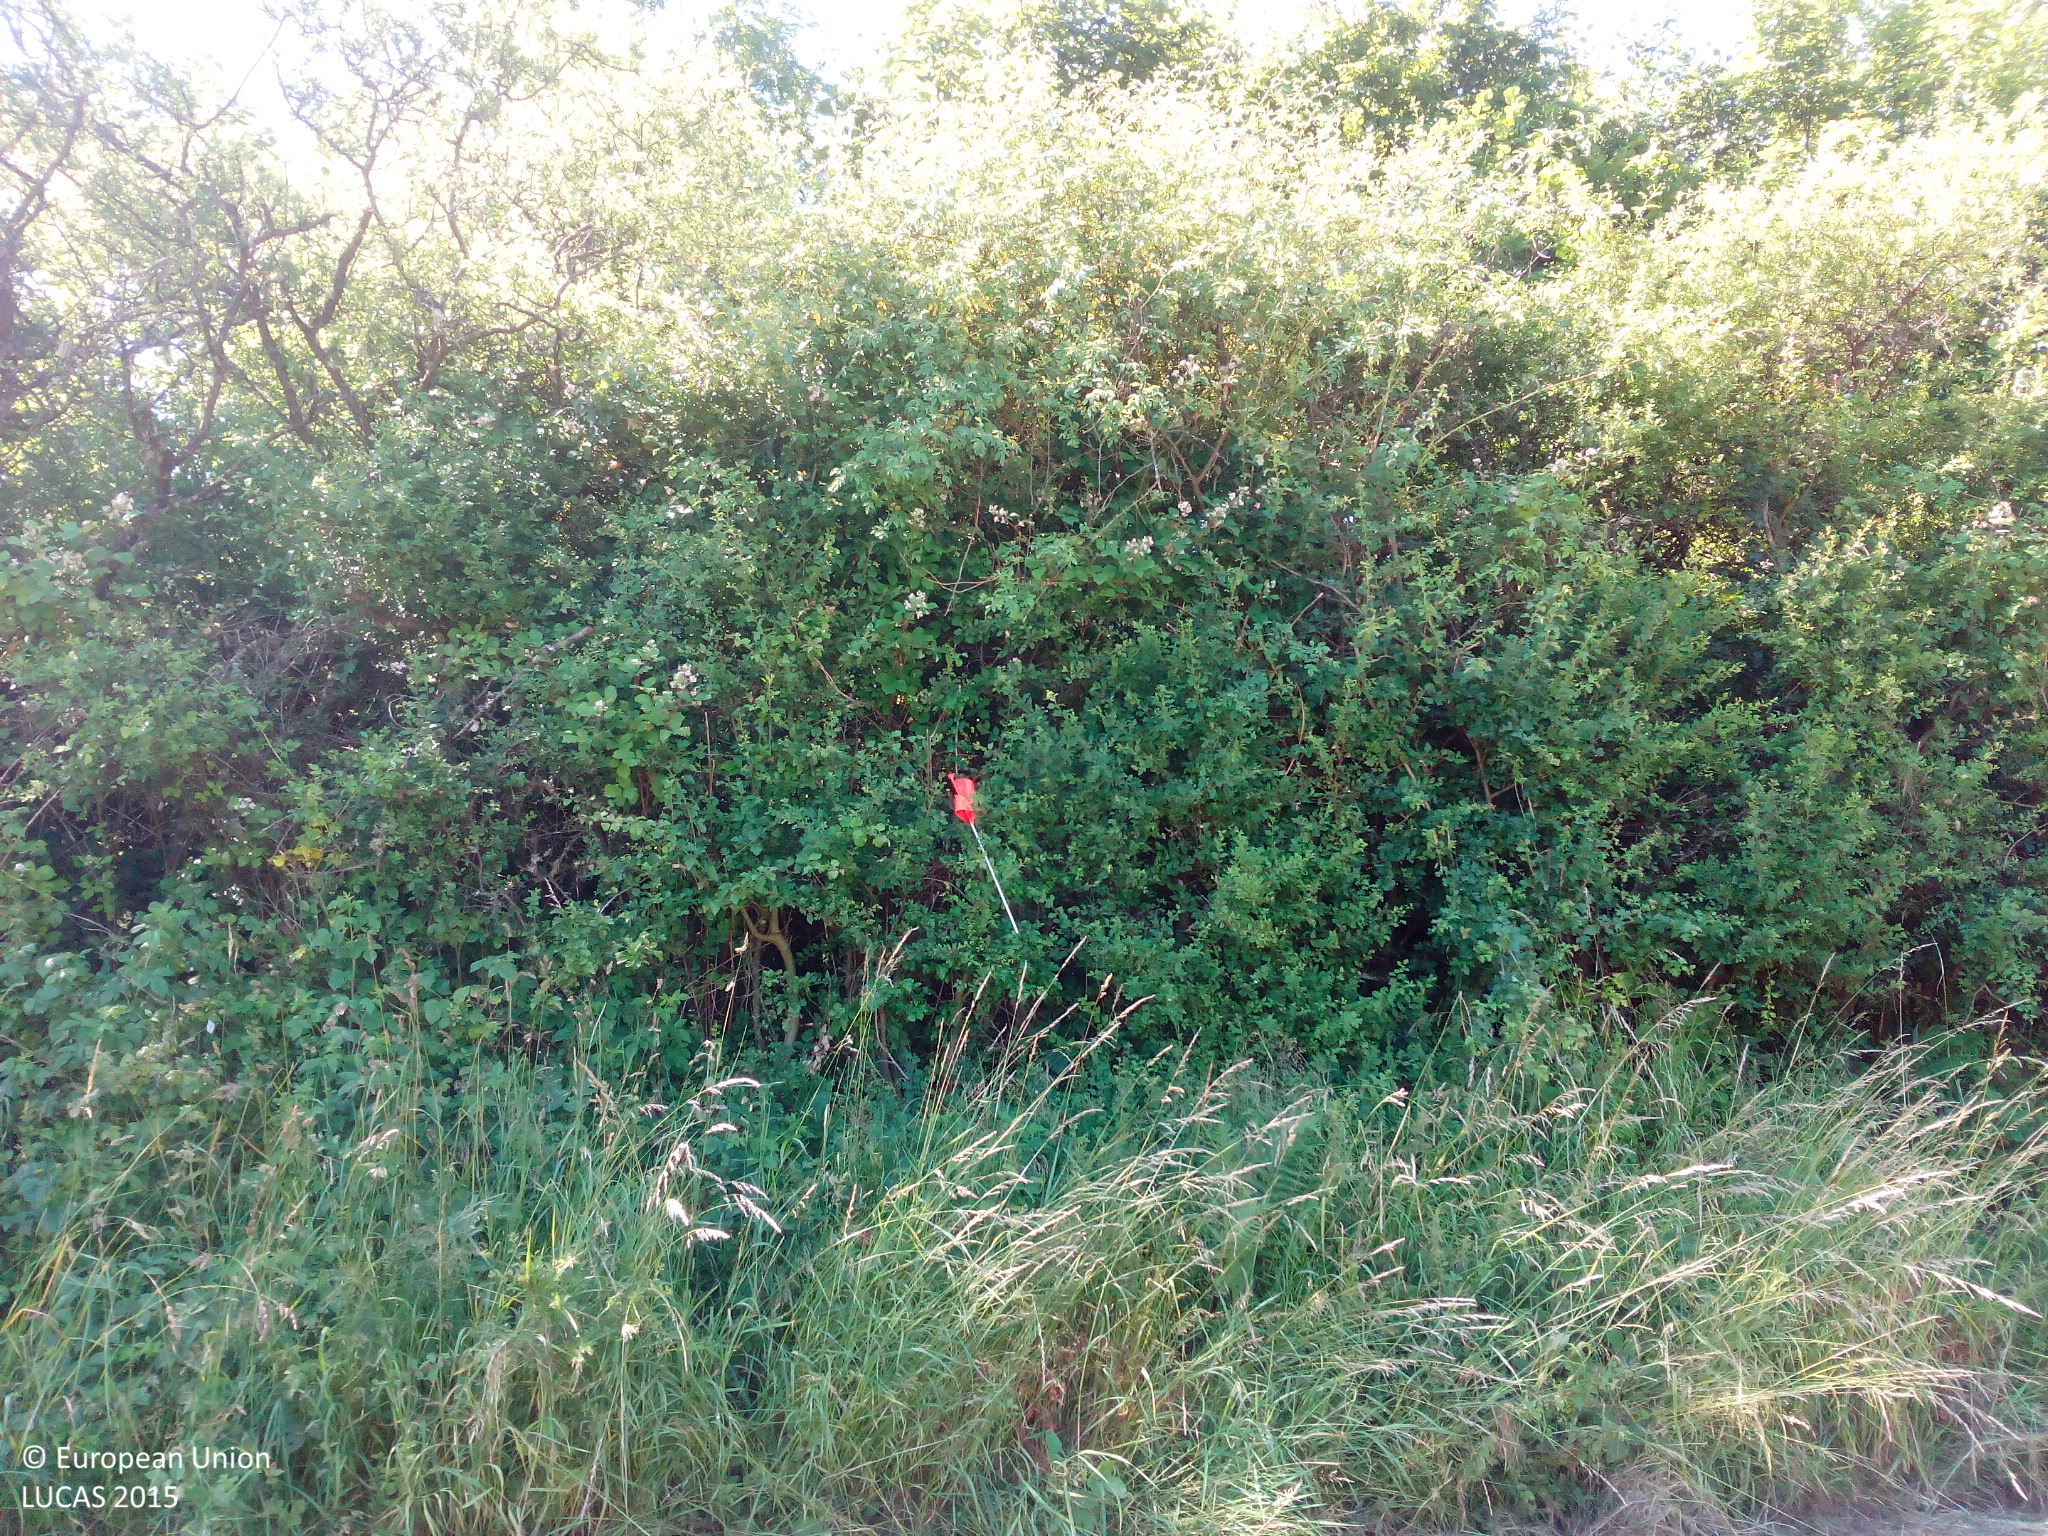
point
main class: Woodland
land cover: Broadleaved woodland
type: acidophilous oak and oak-birch forest
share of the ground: 50 - 75 %
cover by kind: broadleaved forest trees 60 %, shrubs 40 %
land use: Abandoned areas
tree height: < 5 m
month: July
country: DE
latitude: 49.5283
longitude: 7.5550
